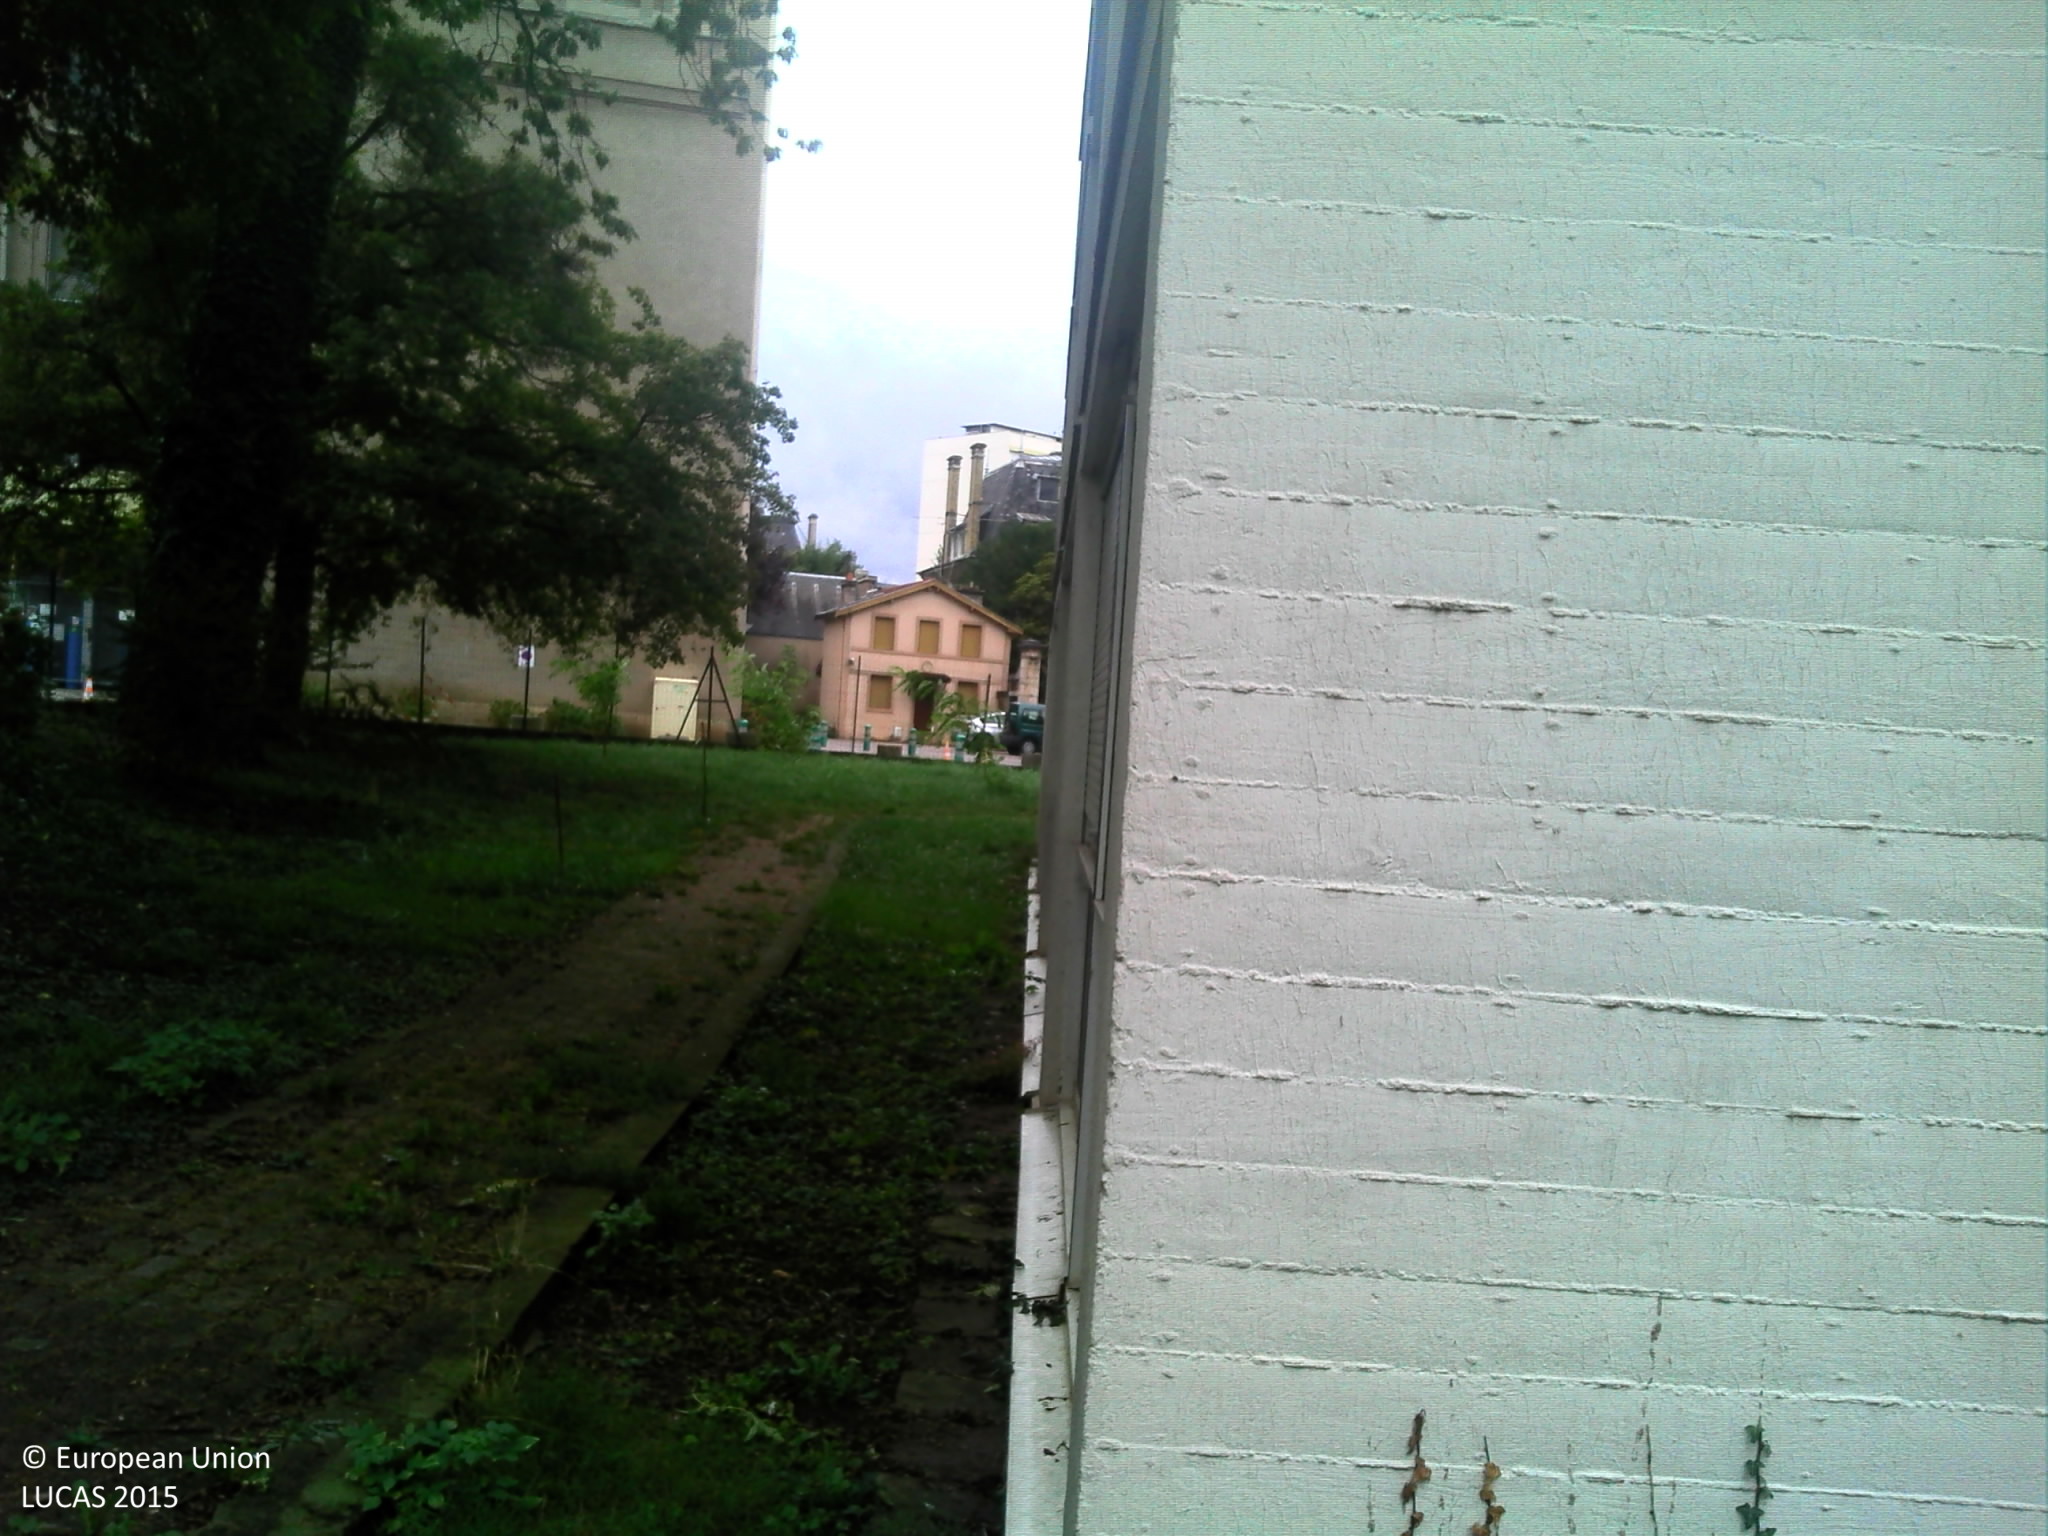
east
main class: Grassland
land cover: Grassland with sparse tree/shrub cover
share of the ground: > 75 %
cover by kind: herbaceous plants 85 %, consolidated bare surface 10 %, broadleaved forest trees 5 %
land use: Residential
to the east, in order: Grassland with sparse tree/shrub cover; Artificial constructions in urban areas
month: September
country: FR
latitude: 48.6799
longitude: 6.1835
